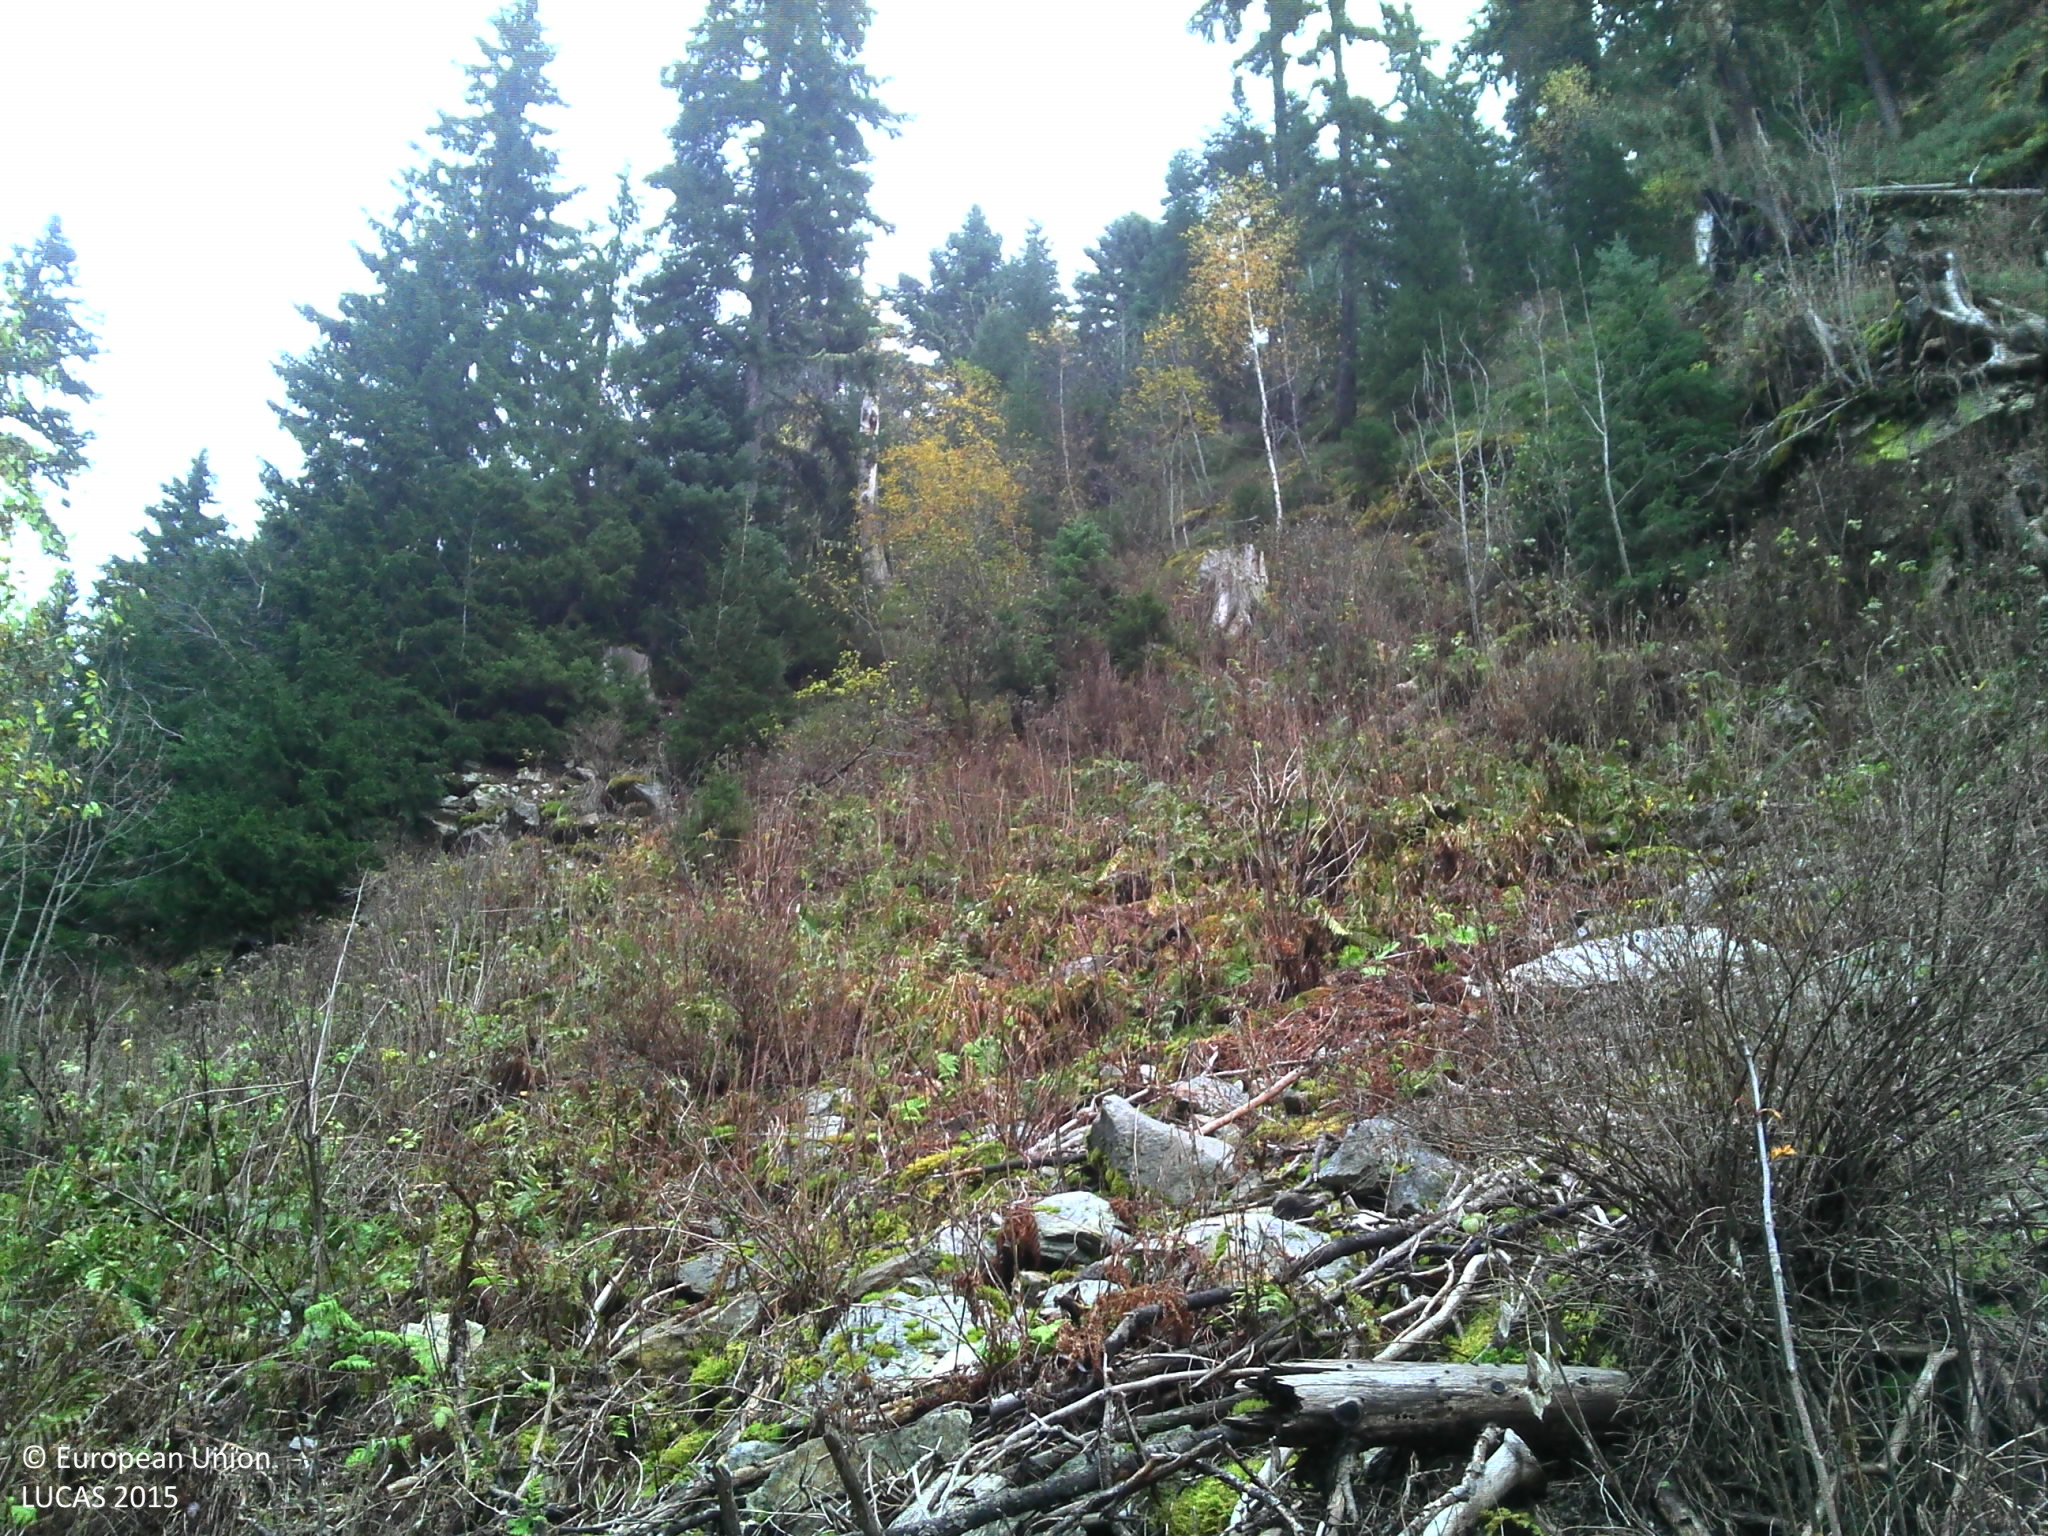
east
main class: Woodland
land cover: Spruce dominated mixed woodland
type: alpine coniferous forest
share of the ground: > 75 %
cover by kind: coniferous forest trees 55 %, broadleaved forest trees 35 %, consolidated bare surface 10 %
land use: Forestry
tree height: > 5 m
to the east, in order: Spruce dominated mixed woodland; Tracks; Spruce dominated mixed woodland
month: October
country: FR
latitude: 45.5729
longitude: 6.5062
